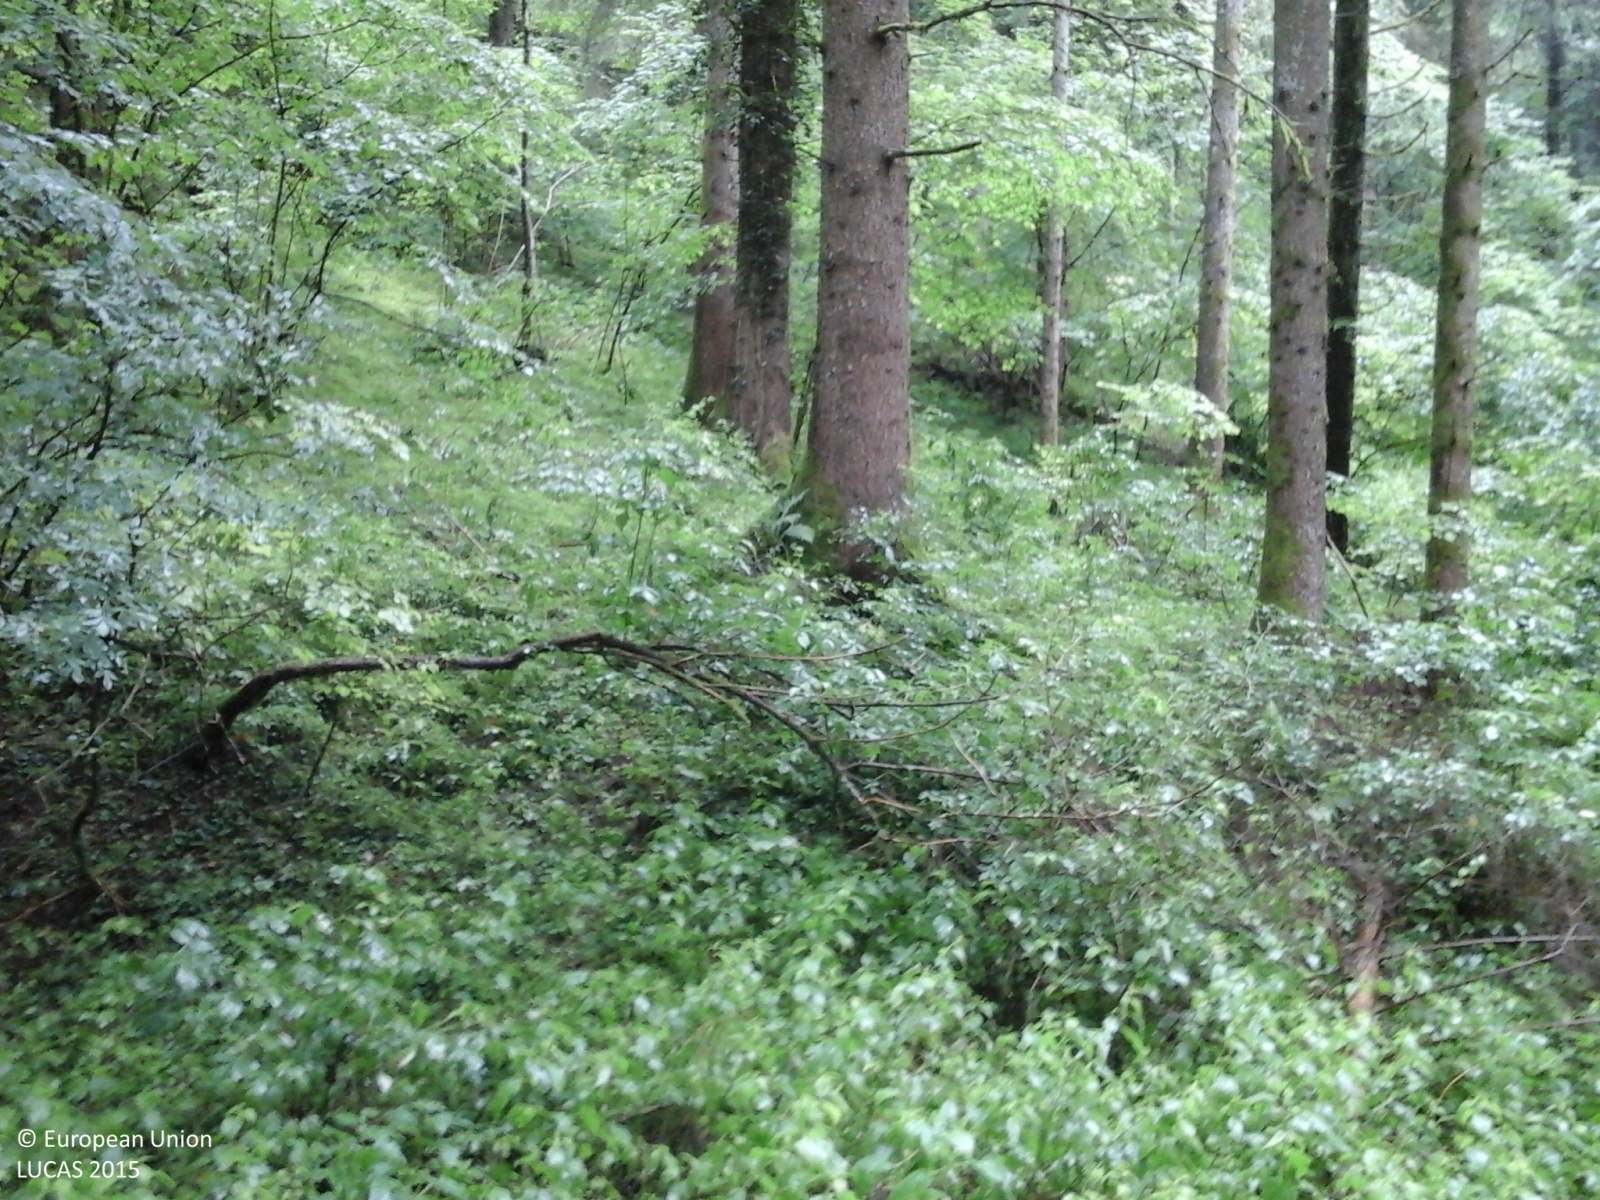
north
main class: Woodland
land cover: Spruce dominated coniferous woodland
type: alpine coniferous forest
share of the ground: > 75 %
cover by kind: coniferous forest trees 80 %, broadleaved forest trees 20 %
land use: Semi-natural and natural areas not in use
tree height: > 5 m
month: June
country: IT
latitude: 45.9059
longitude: 11.6605
